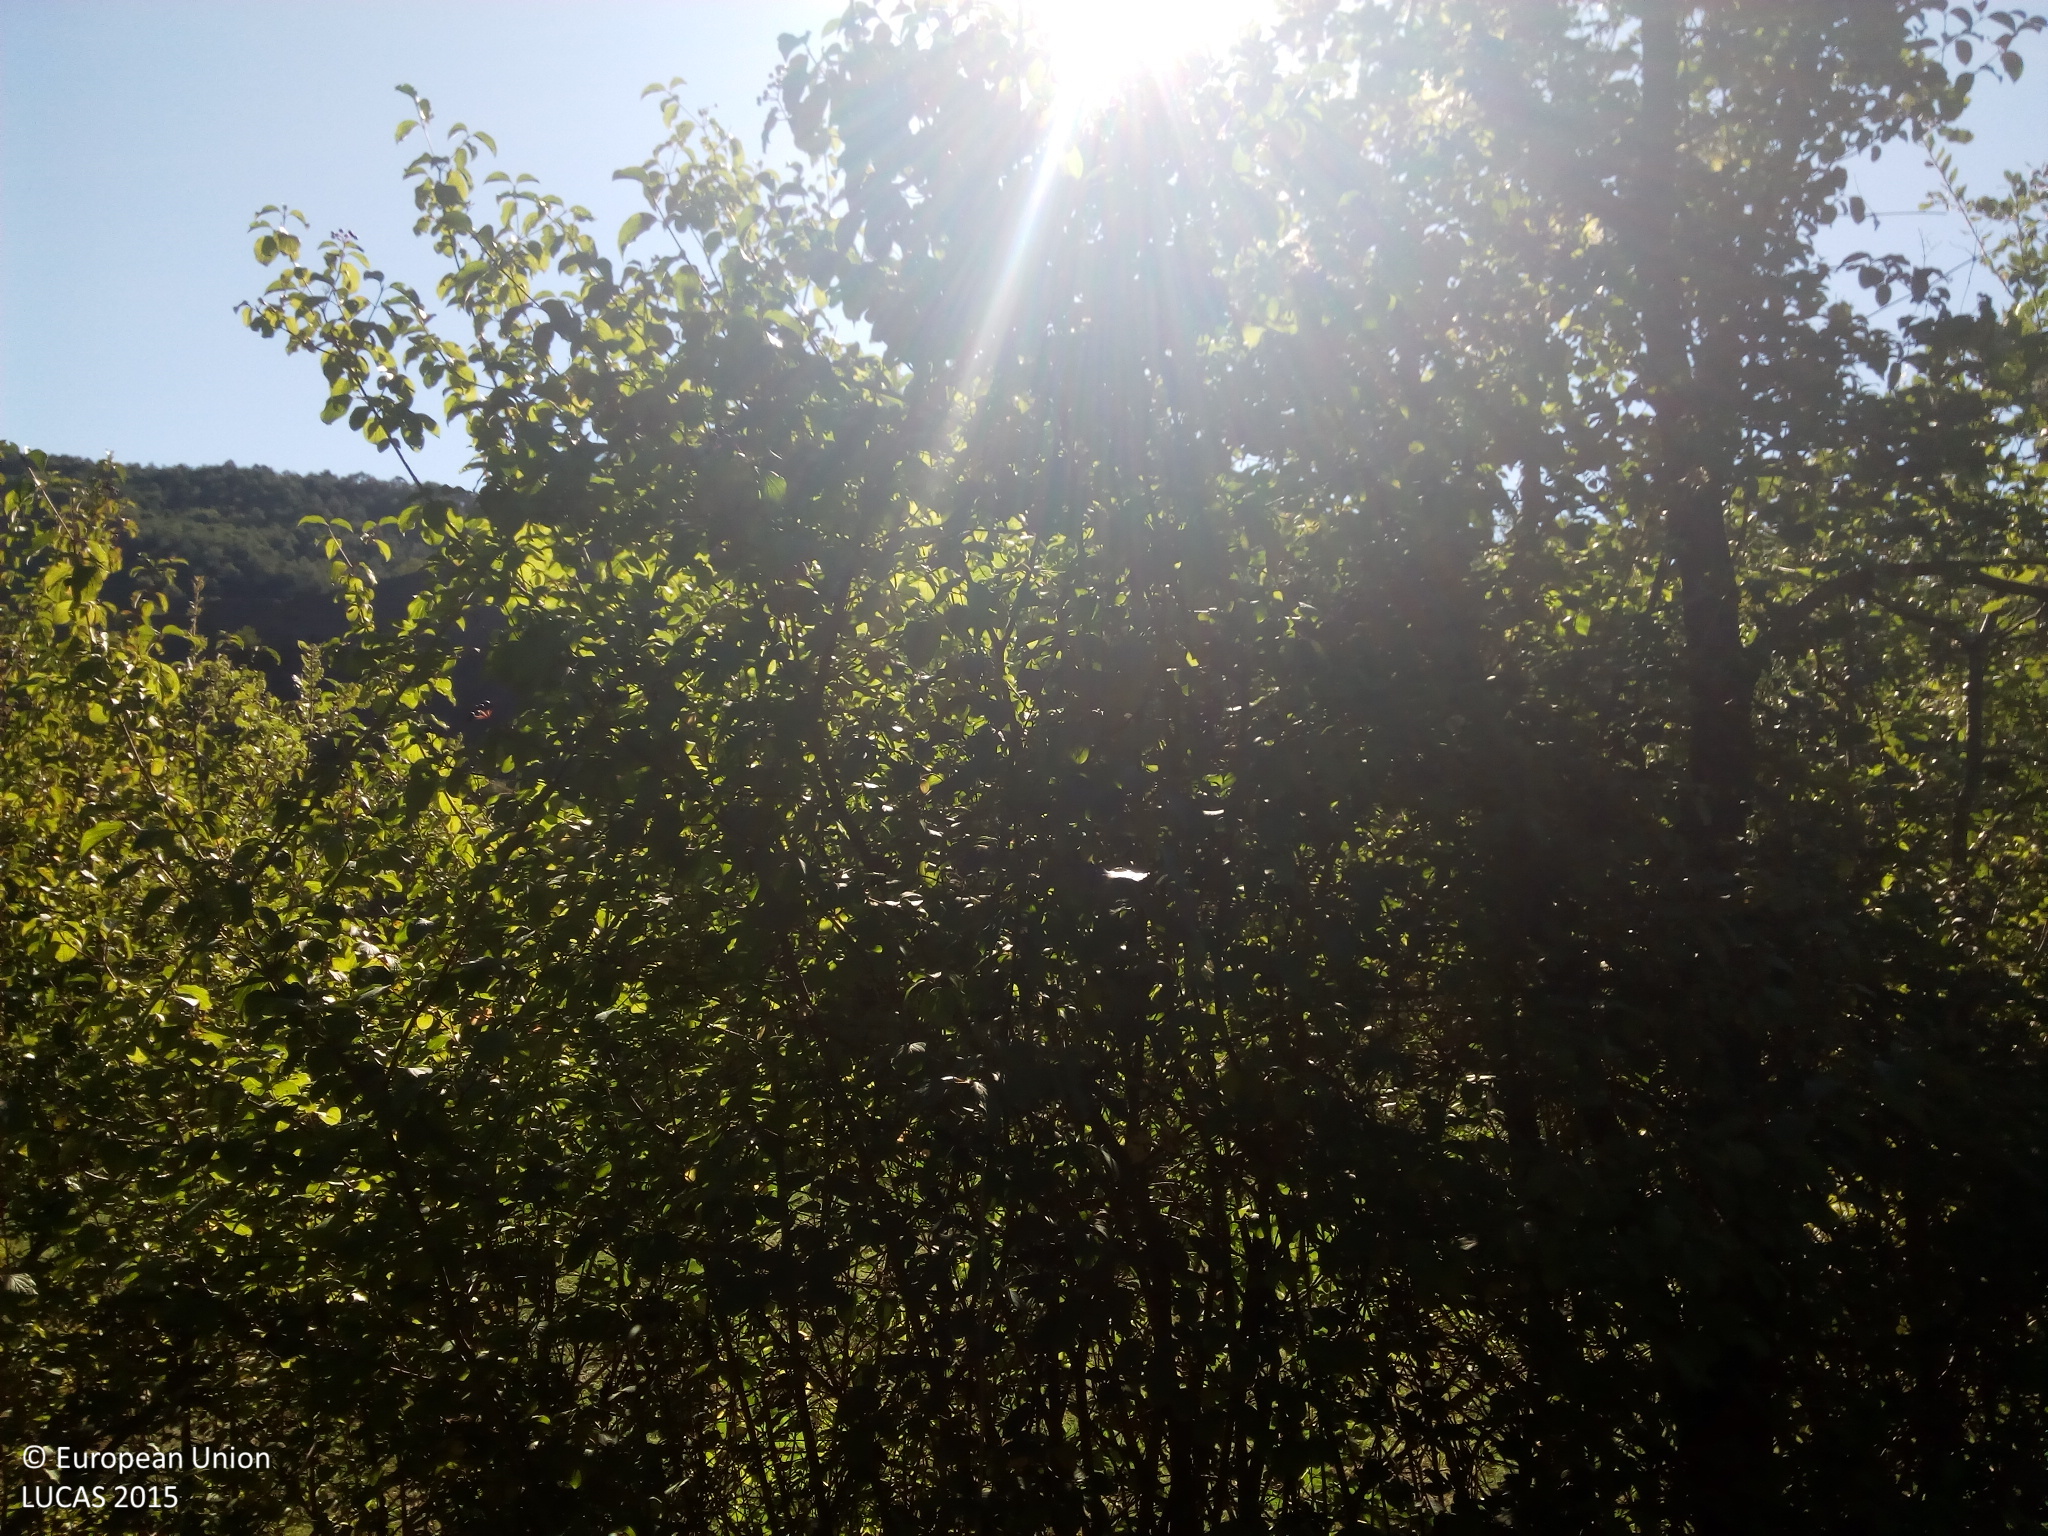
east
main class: Woodland
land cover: Pine dominated mixed woodland
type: alpine coniferous forest
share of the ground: > 75 %
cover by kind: coniferous forest trees 40 %, broadleaved forest trees 30 %, shrubs 20 %, consolidated bare surface 10 %
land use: Semi-natural and natural areas not in use
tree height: > 5 m
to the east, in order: Pine dominated mixed woodland; Spontaneously vegetated surfaces; Broadleaved woodland; Inland fresh running water; Broadleaved woodland; Tracks; Pine dominated coniferous woodland; Grassland without tree/shrub cover; Pine dominated coniferous woodland
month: August
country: ES
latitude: 42.4161
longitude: 0.2211
